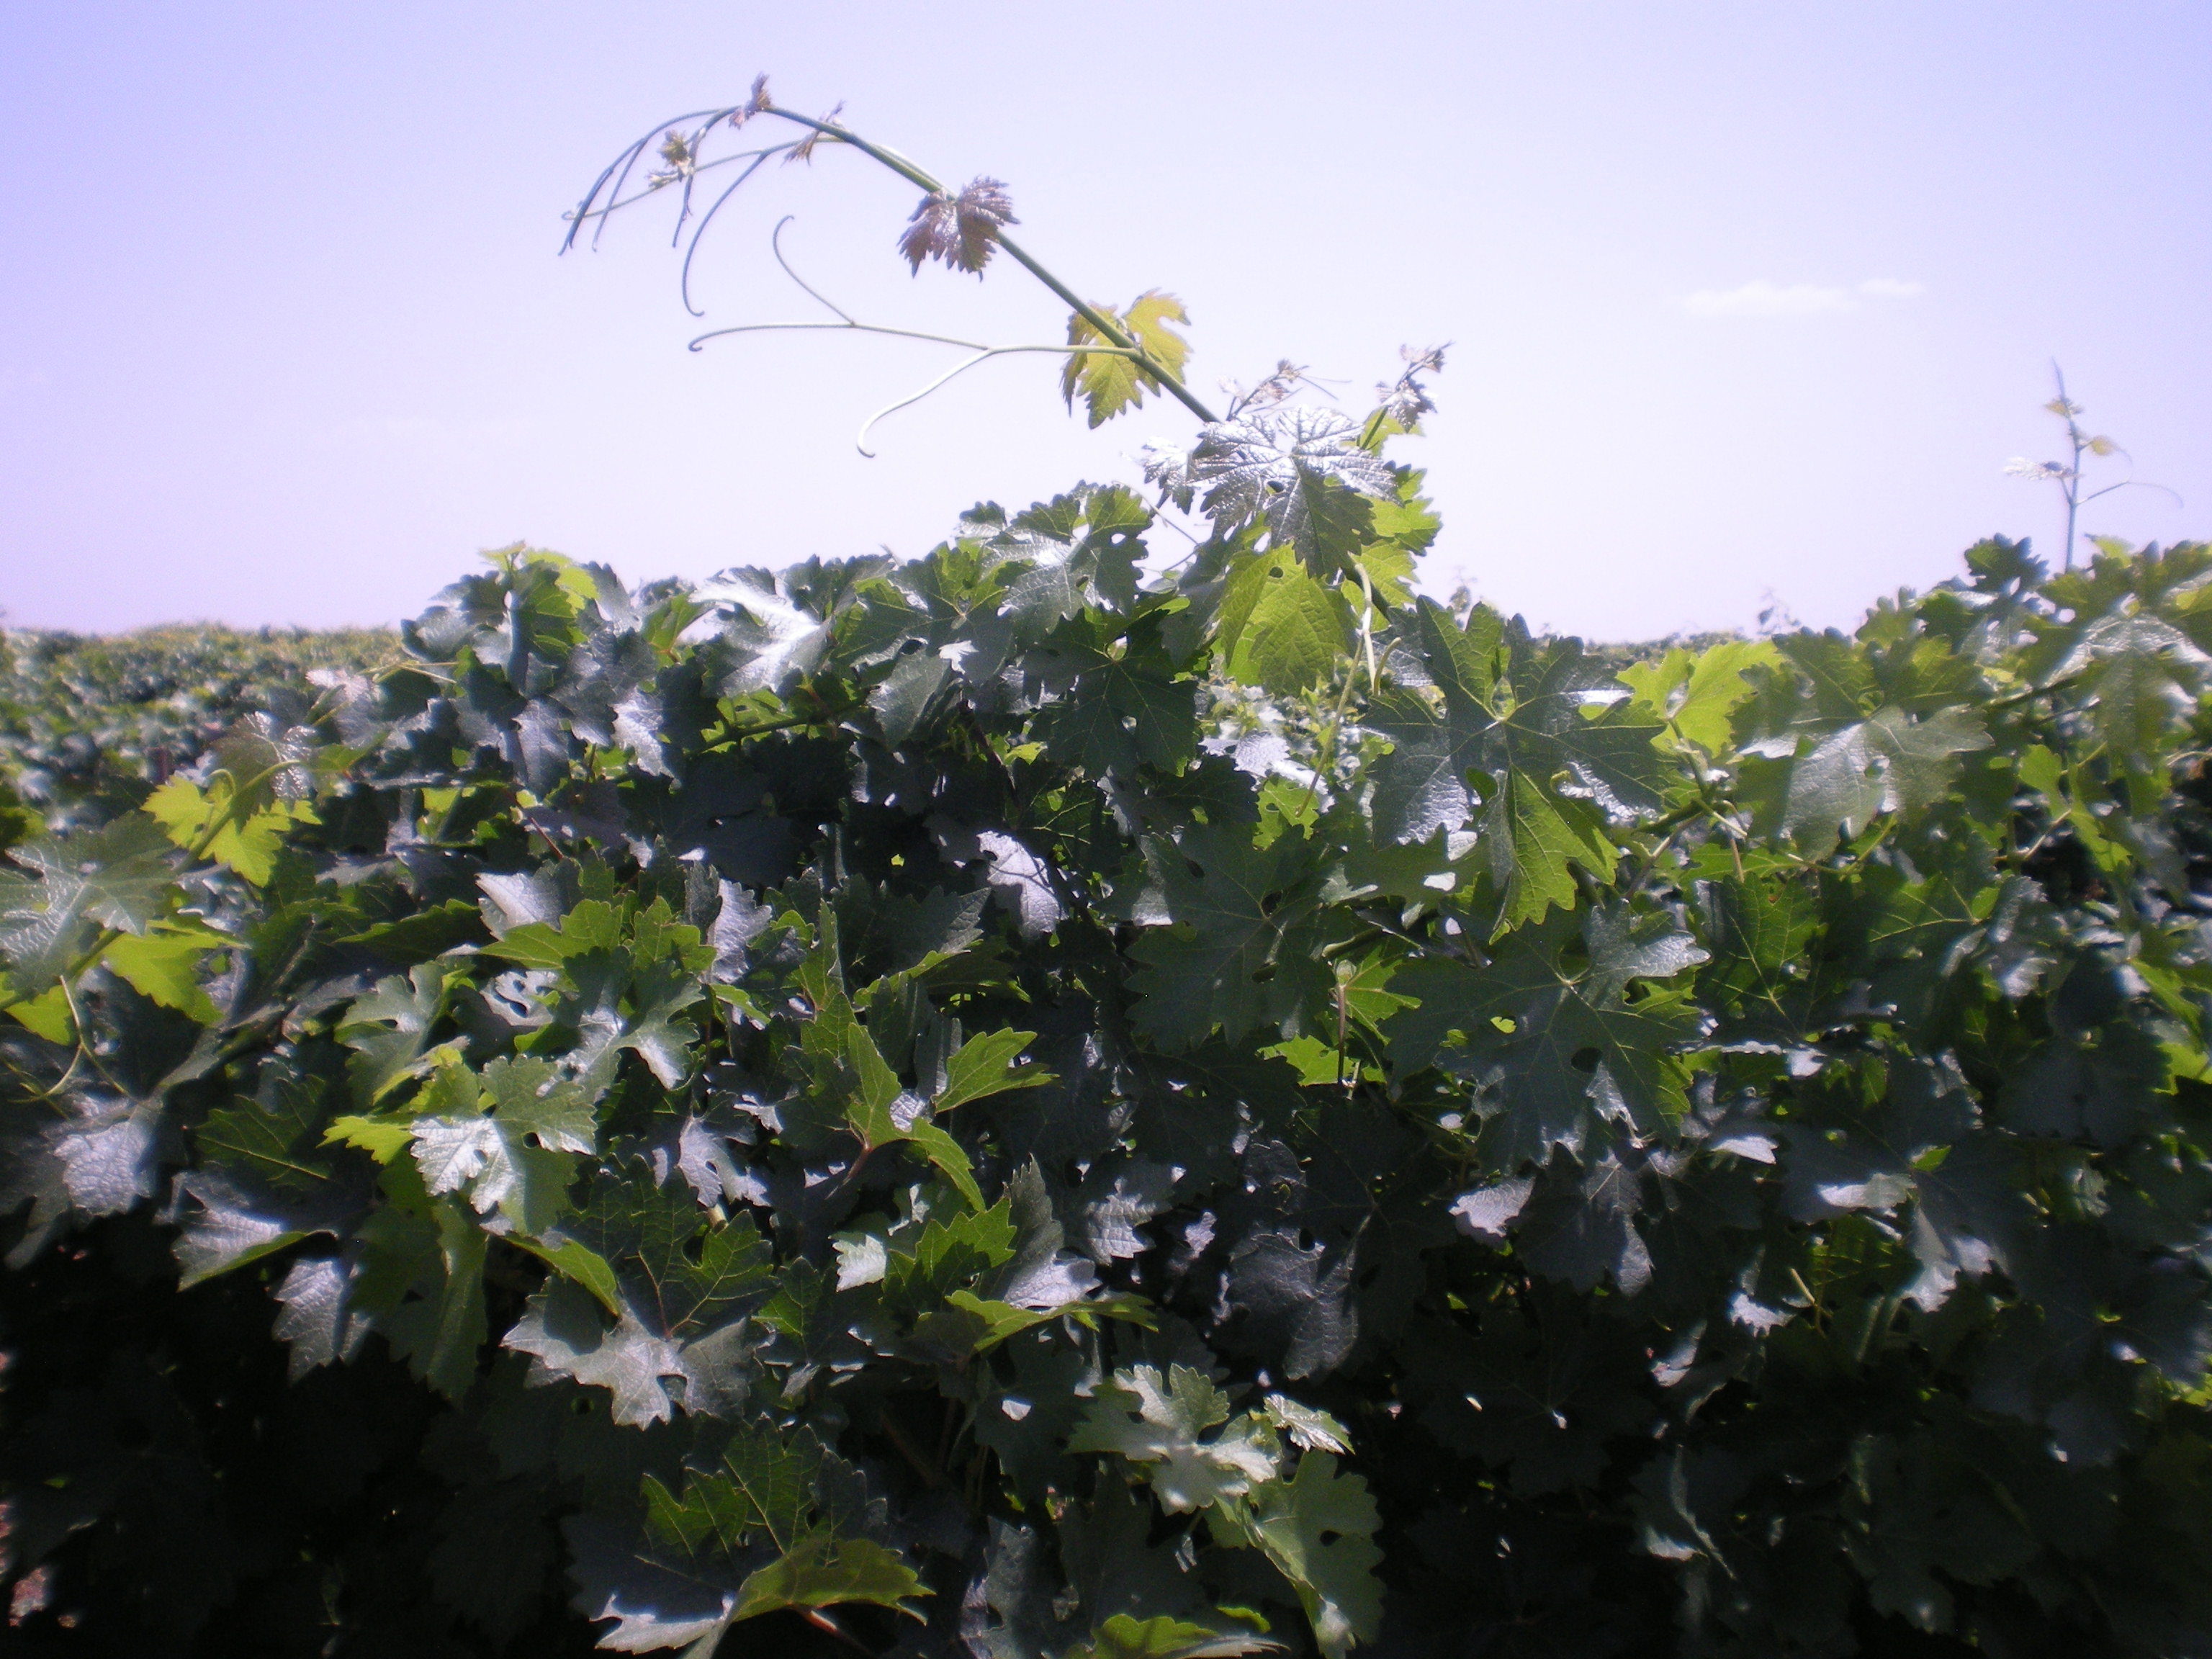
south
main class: Cropland
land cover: Vineyards
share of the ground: 10 - 25 %
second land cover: Other bare soil
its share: > 75 %
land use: Agriculture (excluding fallow land and kitchen gardens)
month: July
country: ES
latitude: 39.2506
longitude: -3.1441
